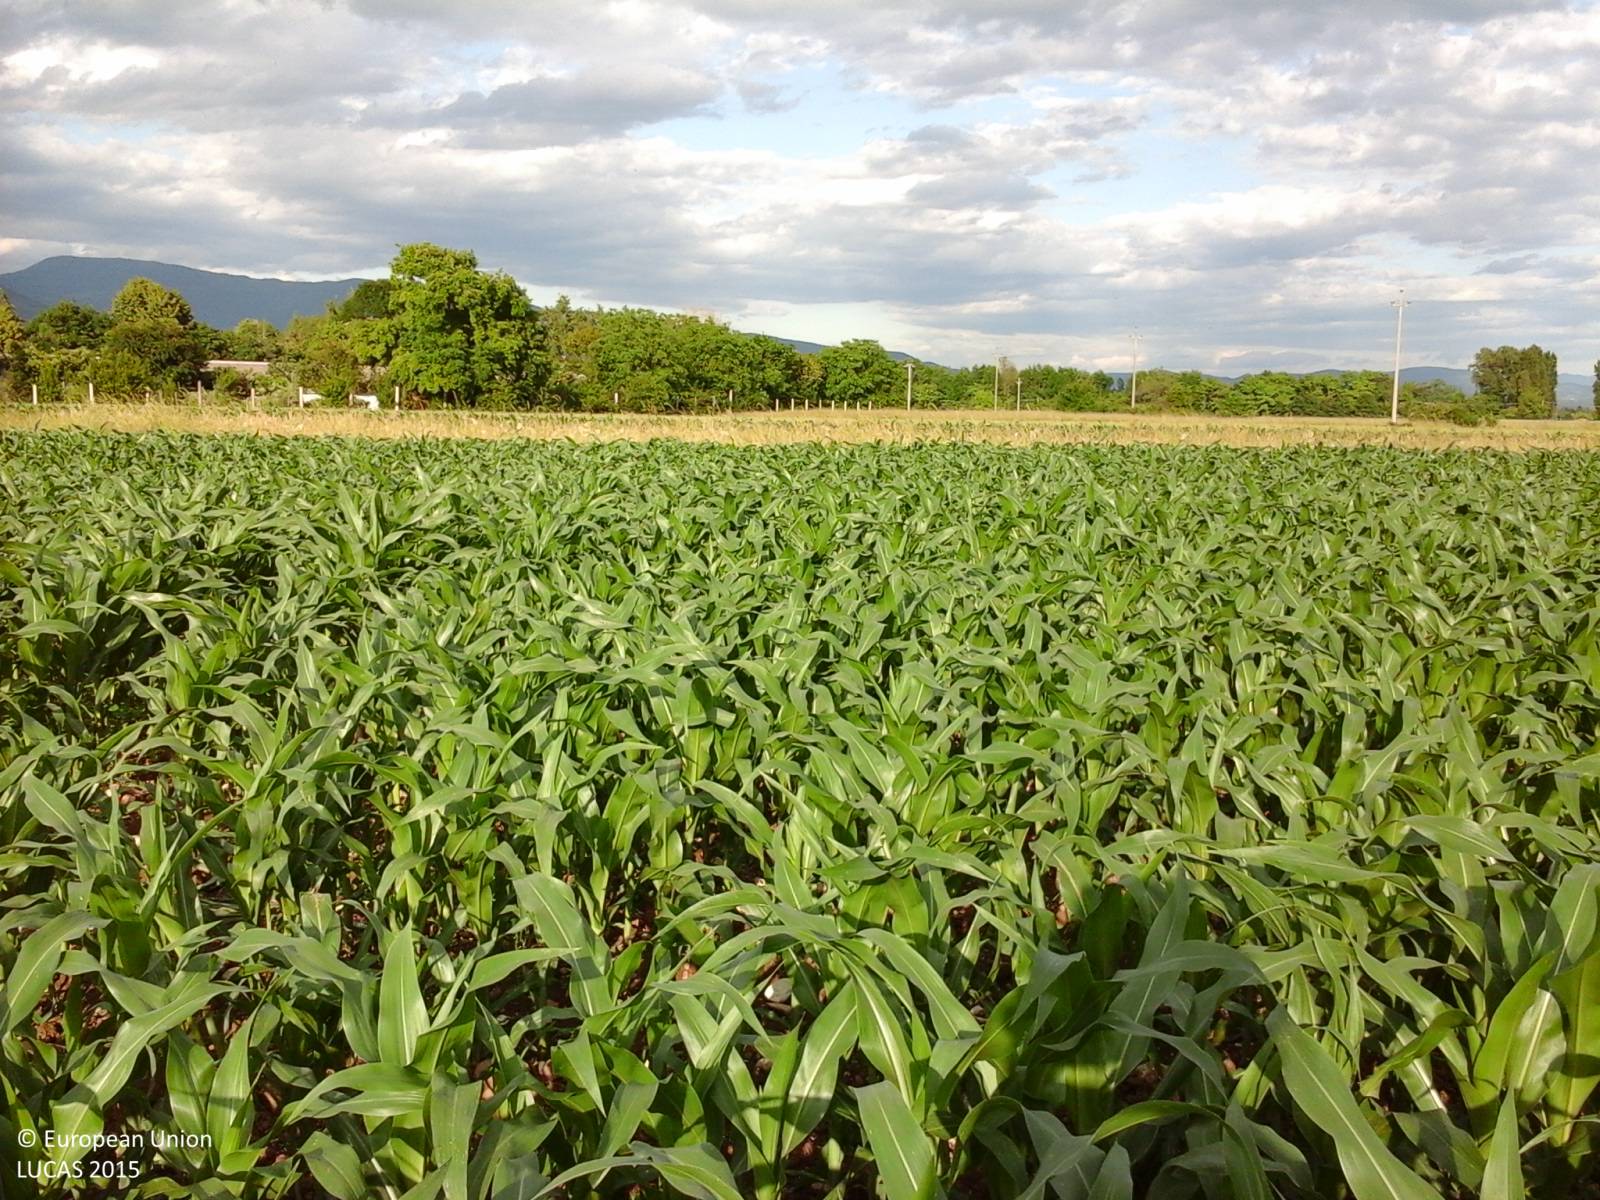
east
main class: Cropland
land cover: Maize
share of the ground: > 75 %
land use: Agriculture (excluding fallow land and kitchen gardens)
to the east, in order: Maize; Grassland without tree/shrub cover; Maize; Lucerne; Temporary grasslands; Soya; Grass margins; Soya; Grassland without tree/shrub cover; Fences; Abandoned hedges; Olive groves; Abandoned hedges; Ditches and canals; Spontaneously vegetated surfaces
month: May
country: IT
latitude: 46.1390
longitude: 13.2716
